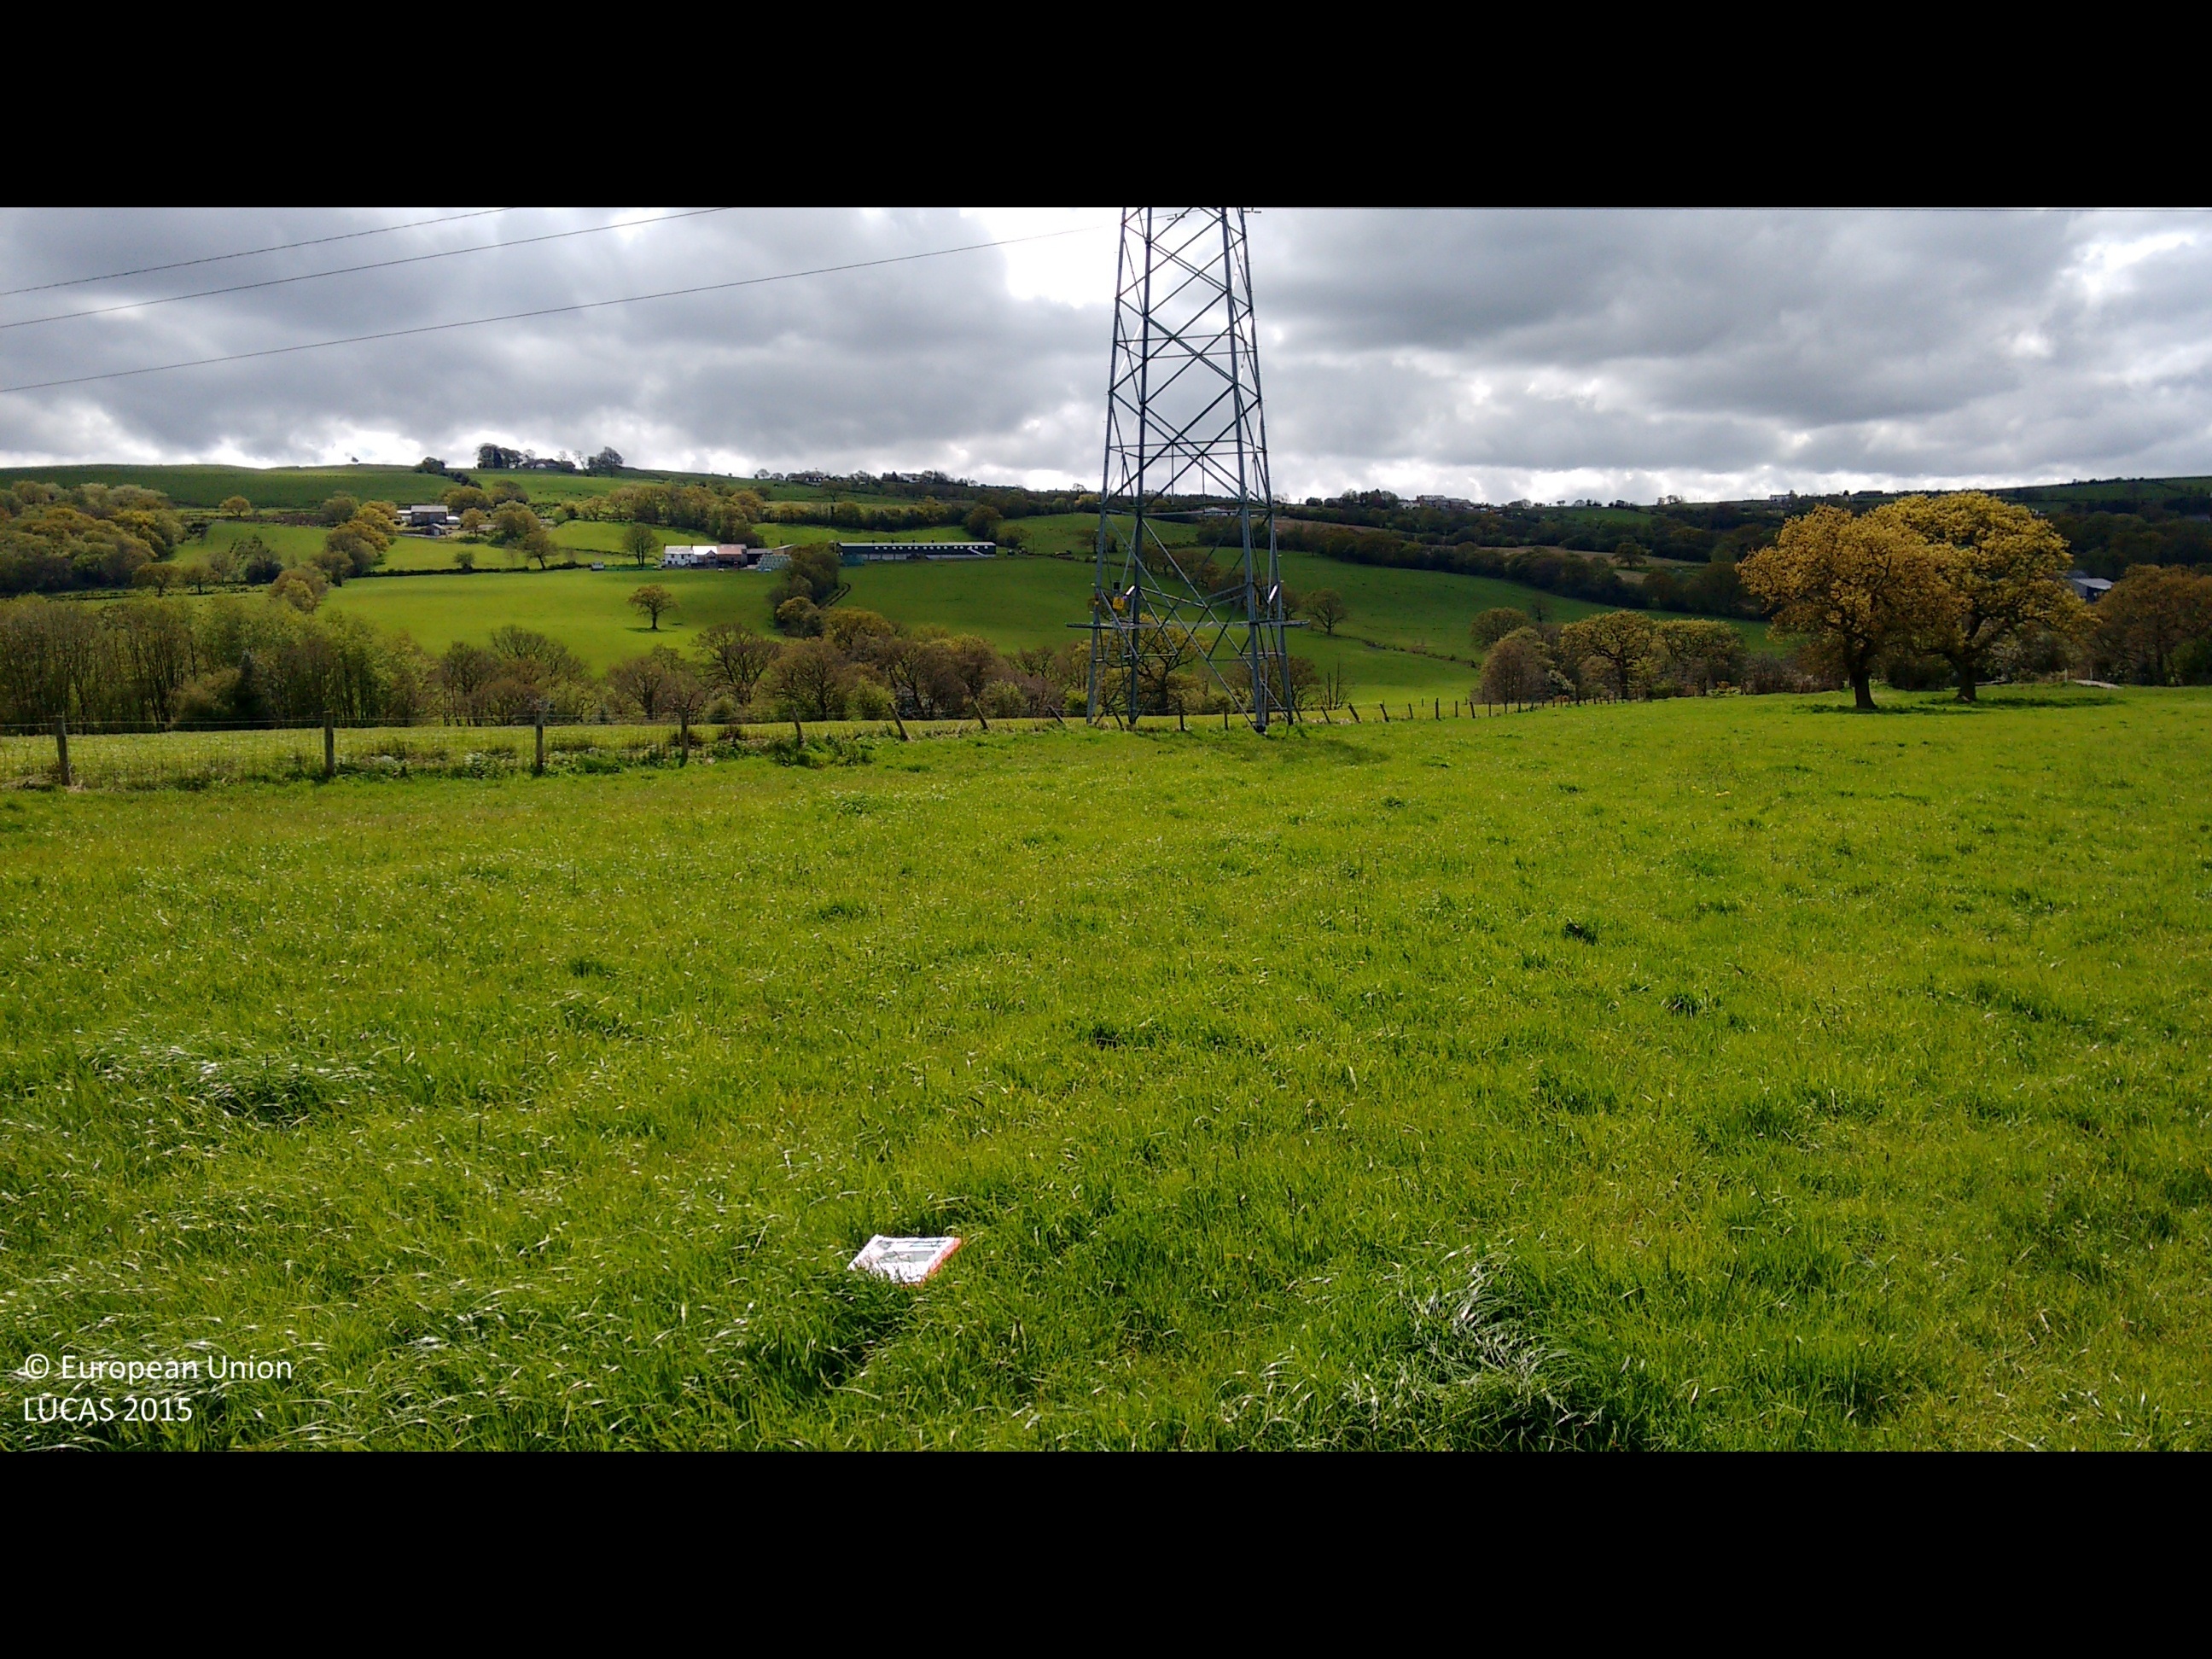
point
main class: Grassland
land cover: Grassland without tree/shrub cover
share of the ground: > 75 %
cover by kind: herbaceous plants 100 %
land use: Agriculture (excluding fallow land and kitchen gardens)
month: May
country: GB
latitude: 53.7891
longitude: -2.4966
